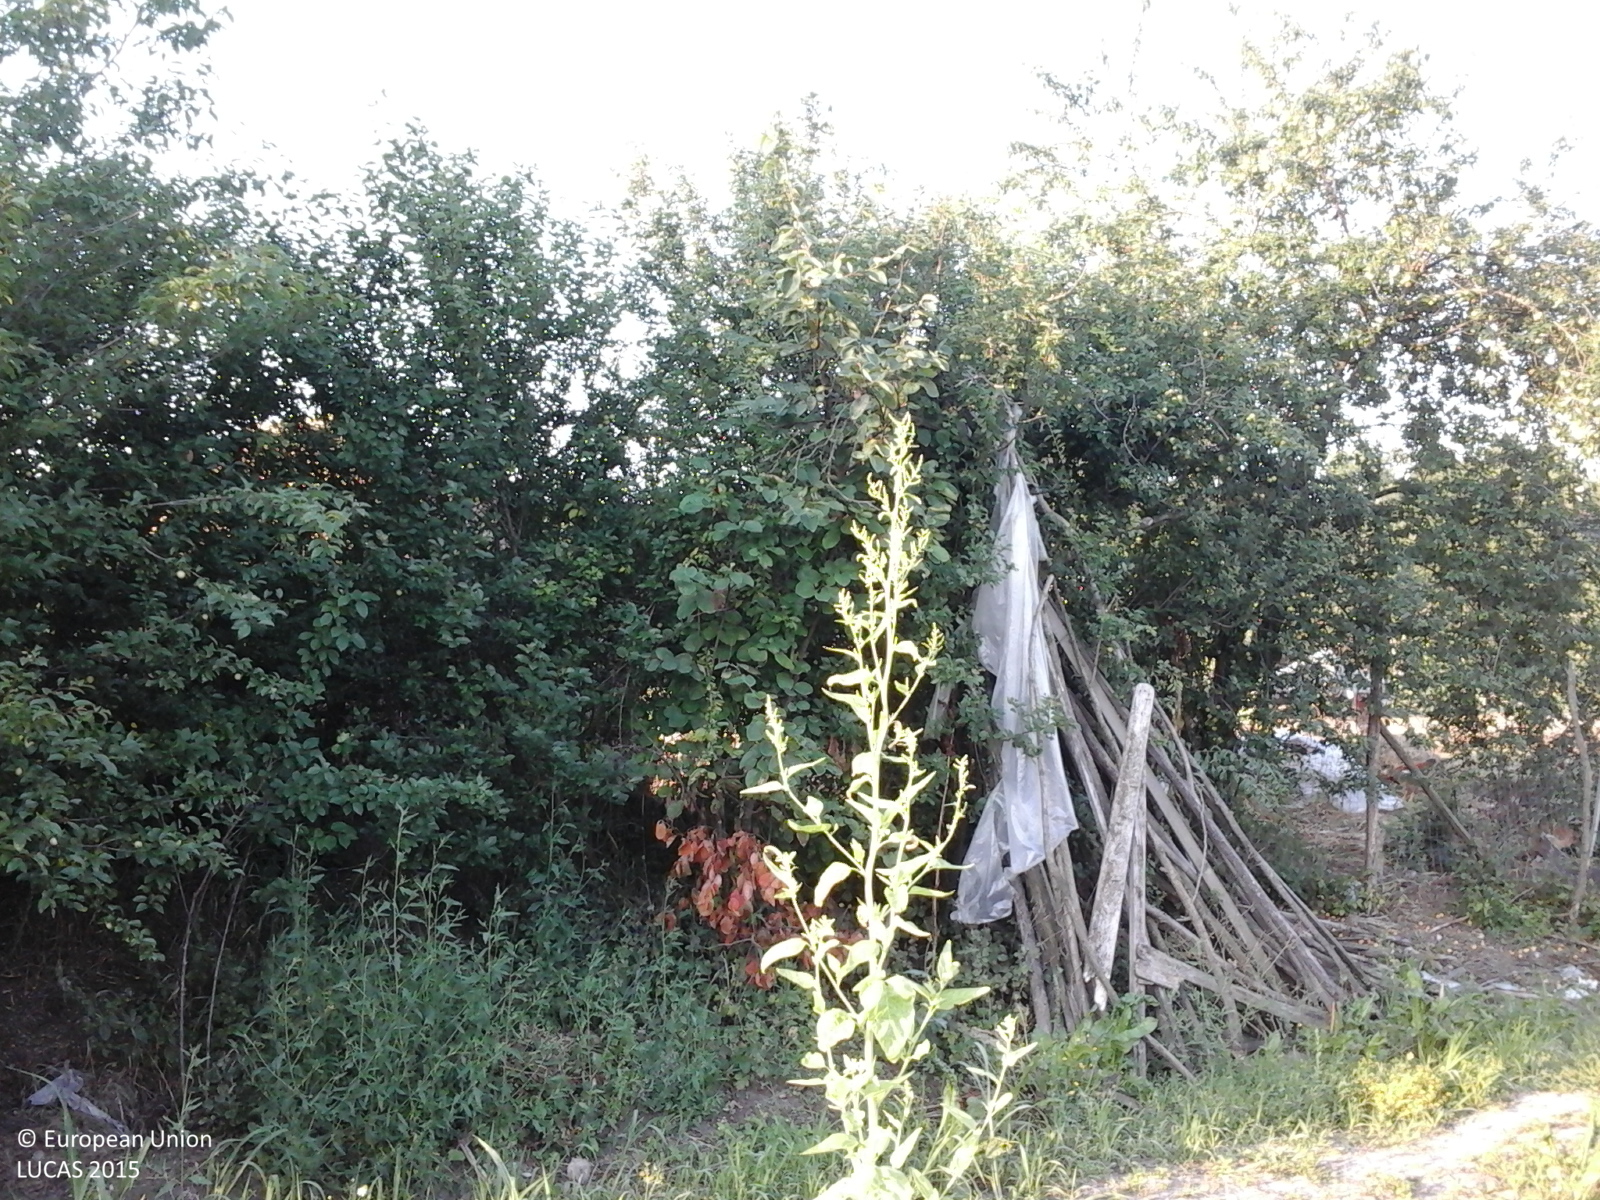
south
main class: Grassland
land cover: Spontaneously vegetated surfaces
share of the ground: 50 - 75 %
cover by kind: herbaceous plants 65 %, unconsolidated bare surface 35 %
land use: Agriculture (excluding fallow land and kitchen gardens)
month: July
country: RO
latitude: 44.5859
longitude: 24.6477
